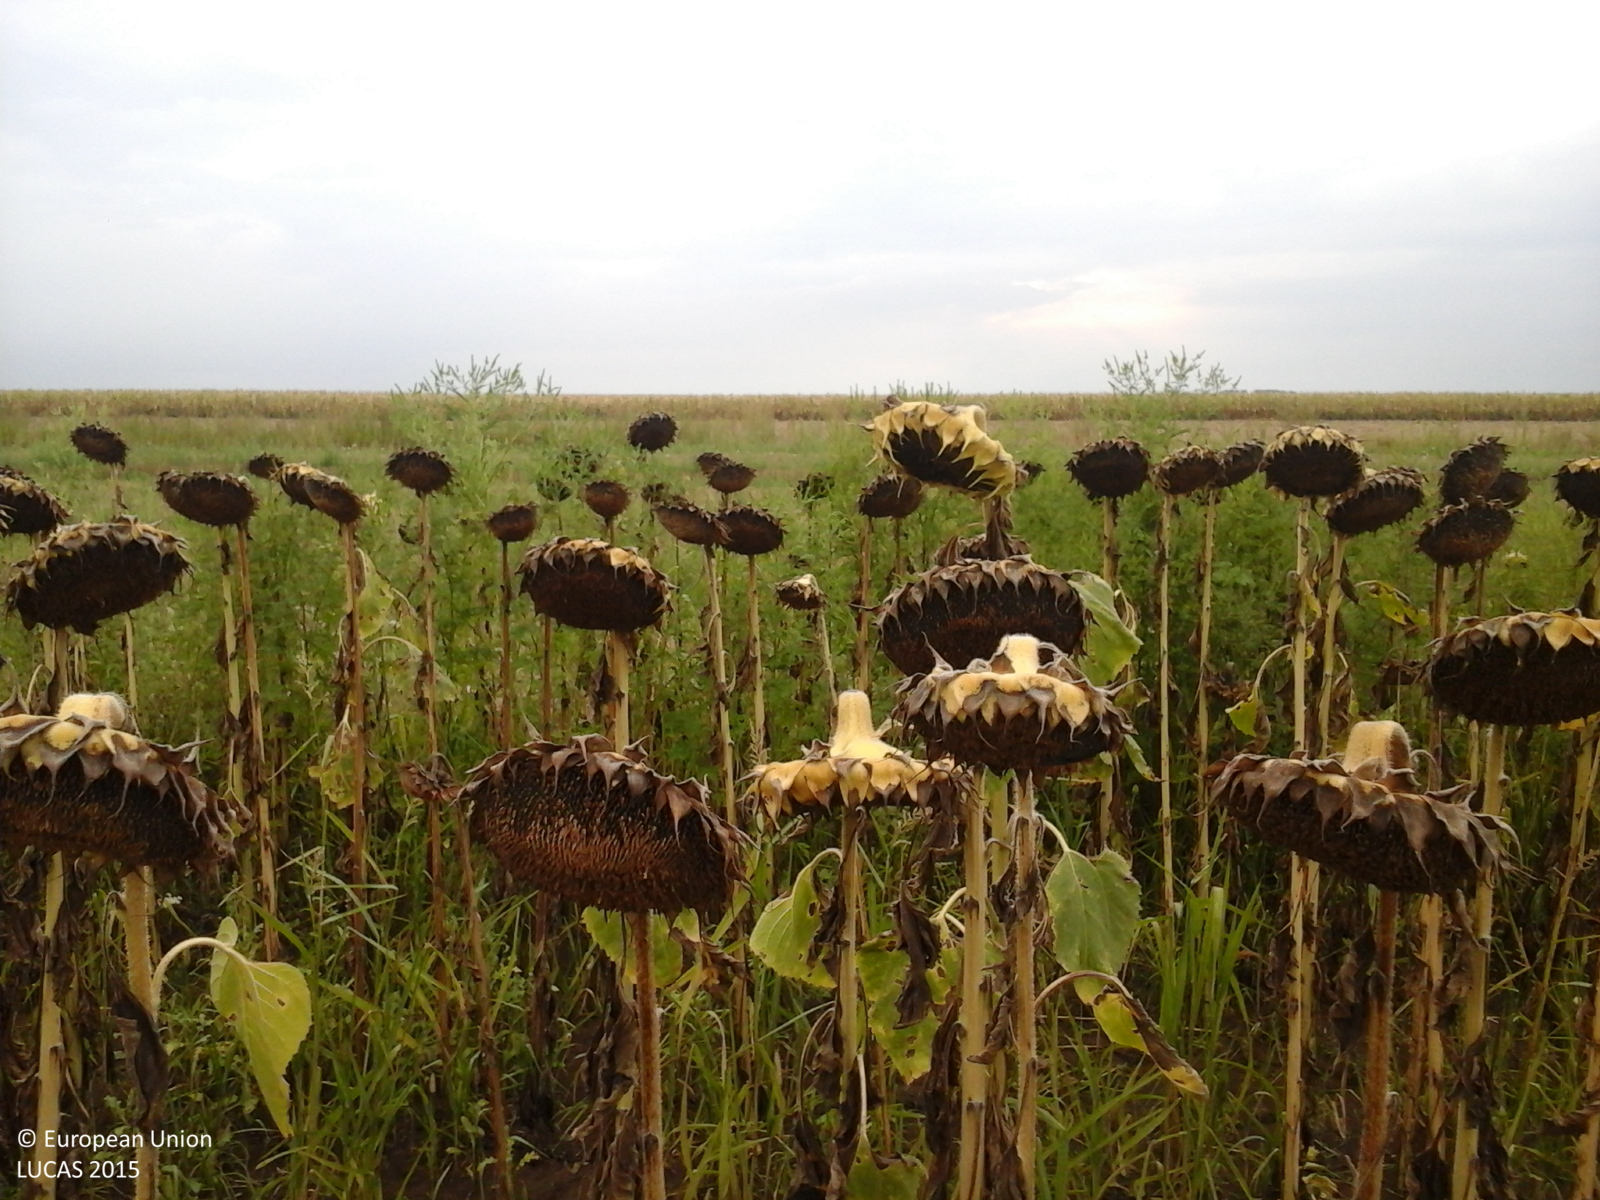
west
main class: Cropland
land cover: Sunflower
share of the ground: > 75 %
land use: Agriculture (excluding fallow land and kitchen gardens)
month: August
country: RO
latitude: 45.7839
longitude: 21.4943
